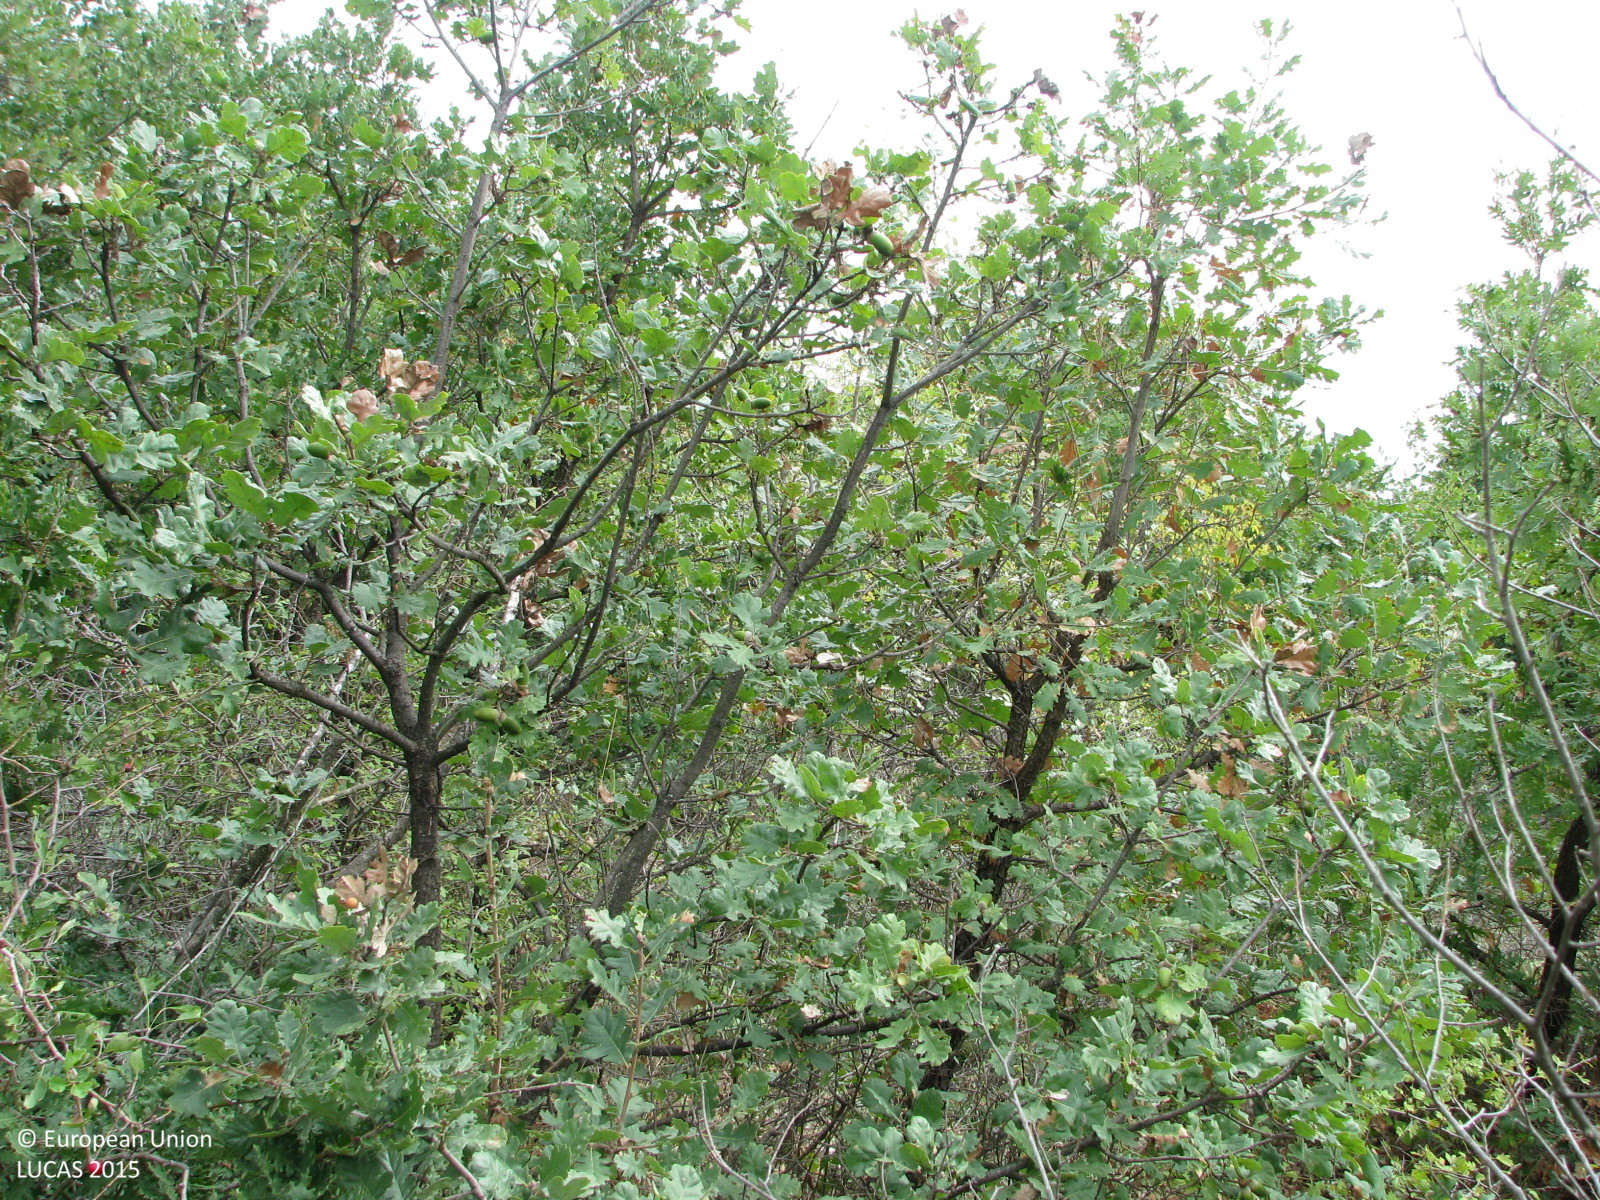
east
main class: Shrubland
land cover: Shrubland with sparse tree cover
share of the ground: > 75 %
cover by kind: shrubs 90 %, broadleaved forest trees 5 %, herbaceous plants 5 %
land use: Semi-natural and natural areas not in use
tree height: < 5 m
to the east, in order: Shrubland with sparse tree cover; Broadleaved woodland; Shrubland with sparse tree cover; Tracks; Broadleaved woodland
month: October
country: BG
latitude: 42.4124
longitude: 26.1598
